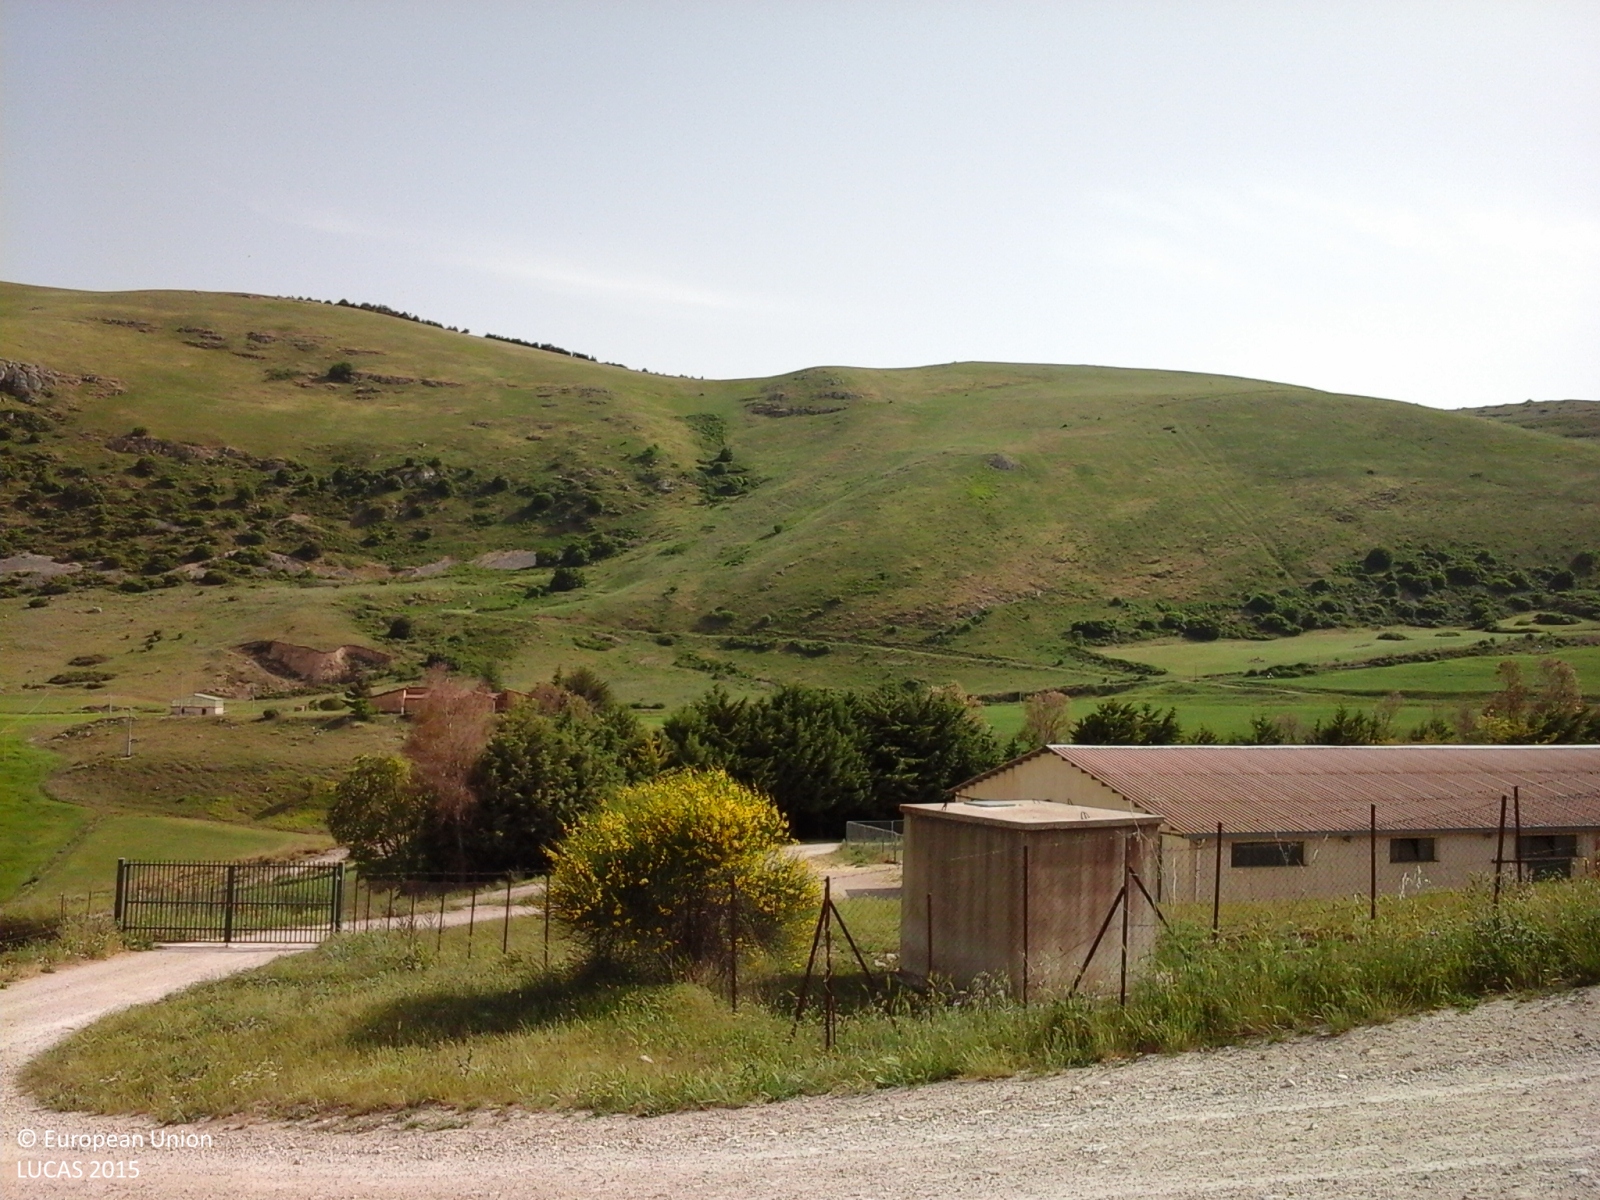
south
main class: Shrubland
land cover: Shrubland with sparse tree cover
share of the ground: > 75 %
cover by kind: shrubs 95 %, broadleaved forest trees 5 %
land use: Agriculture (excluding fallow land and kitchen gardens)
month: May
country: IT
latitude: 37.6279
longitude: 13.5203
